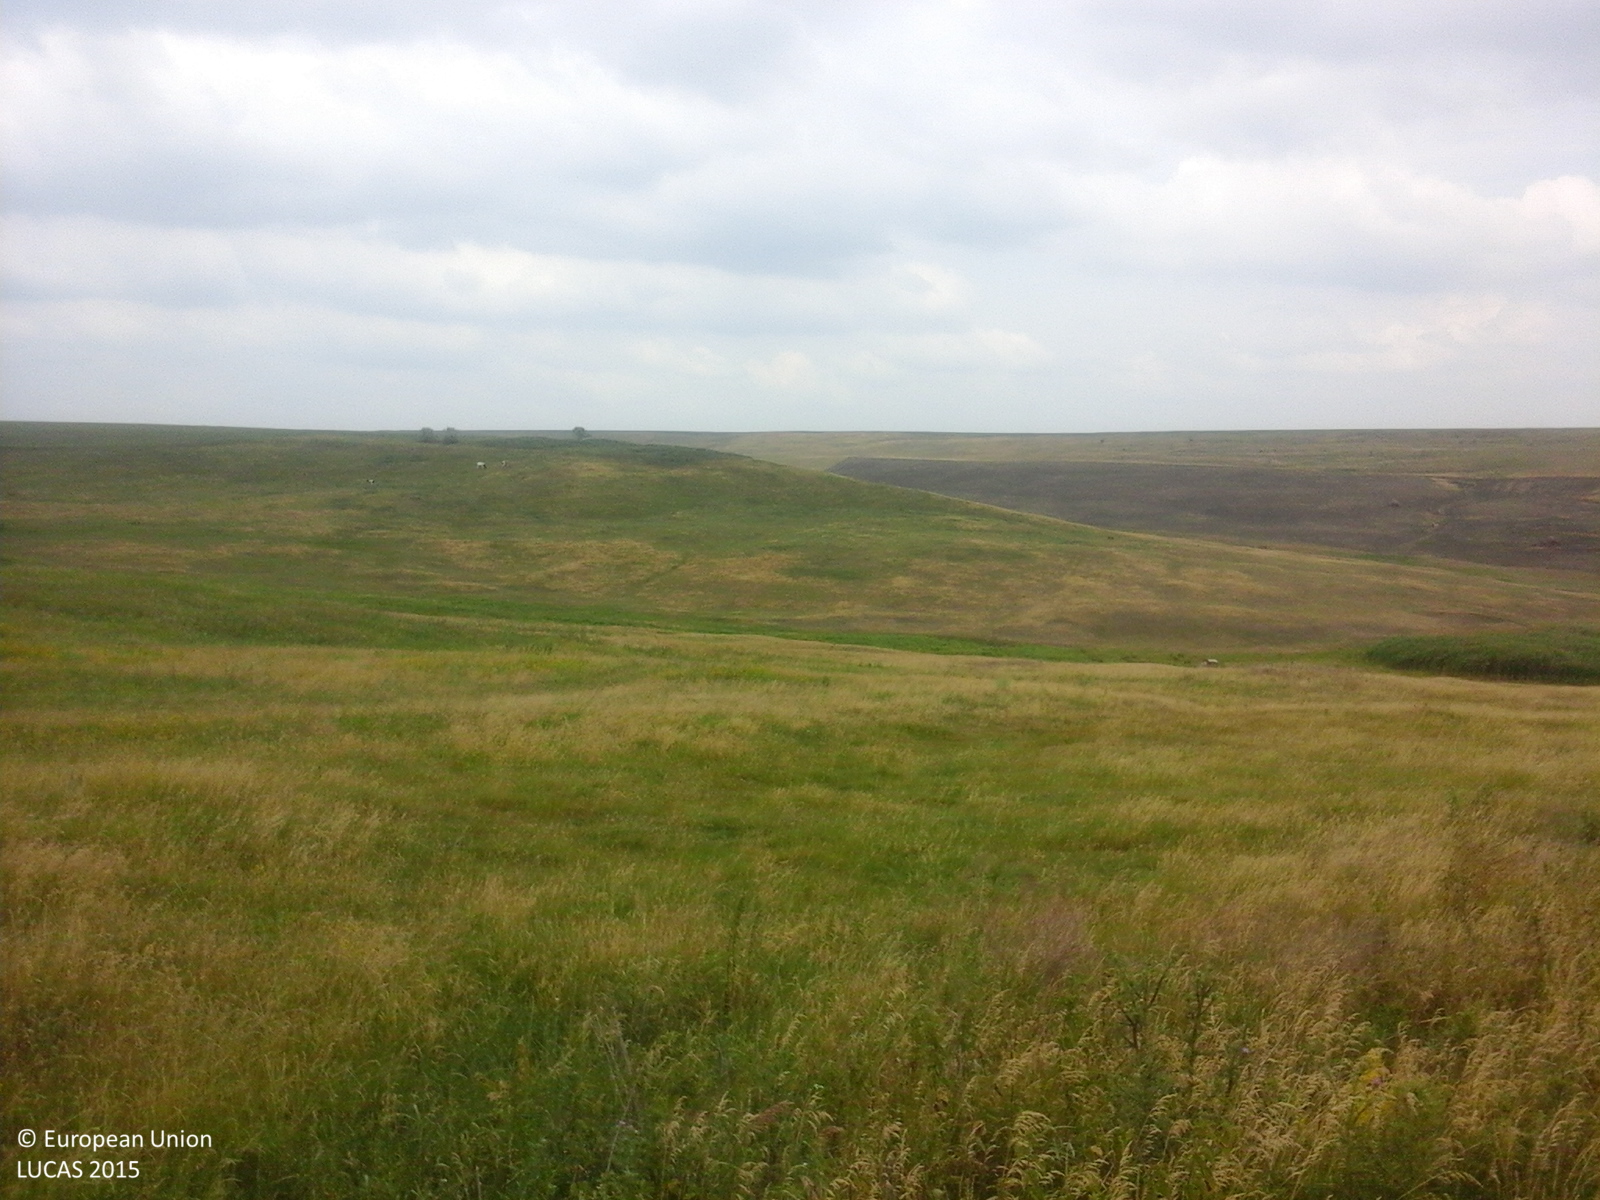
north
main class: Grassland
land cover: Grassland without tree/shrub cover
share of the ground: > 75 %
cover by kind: herbaceous plants 100 %
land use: Agriculture (excluding fallow land and kitchen gardens)
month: June
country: RO
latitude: 47.8722
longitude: 26.7159
